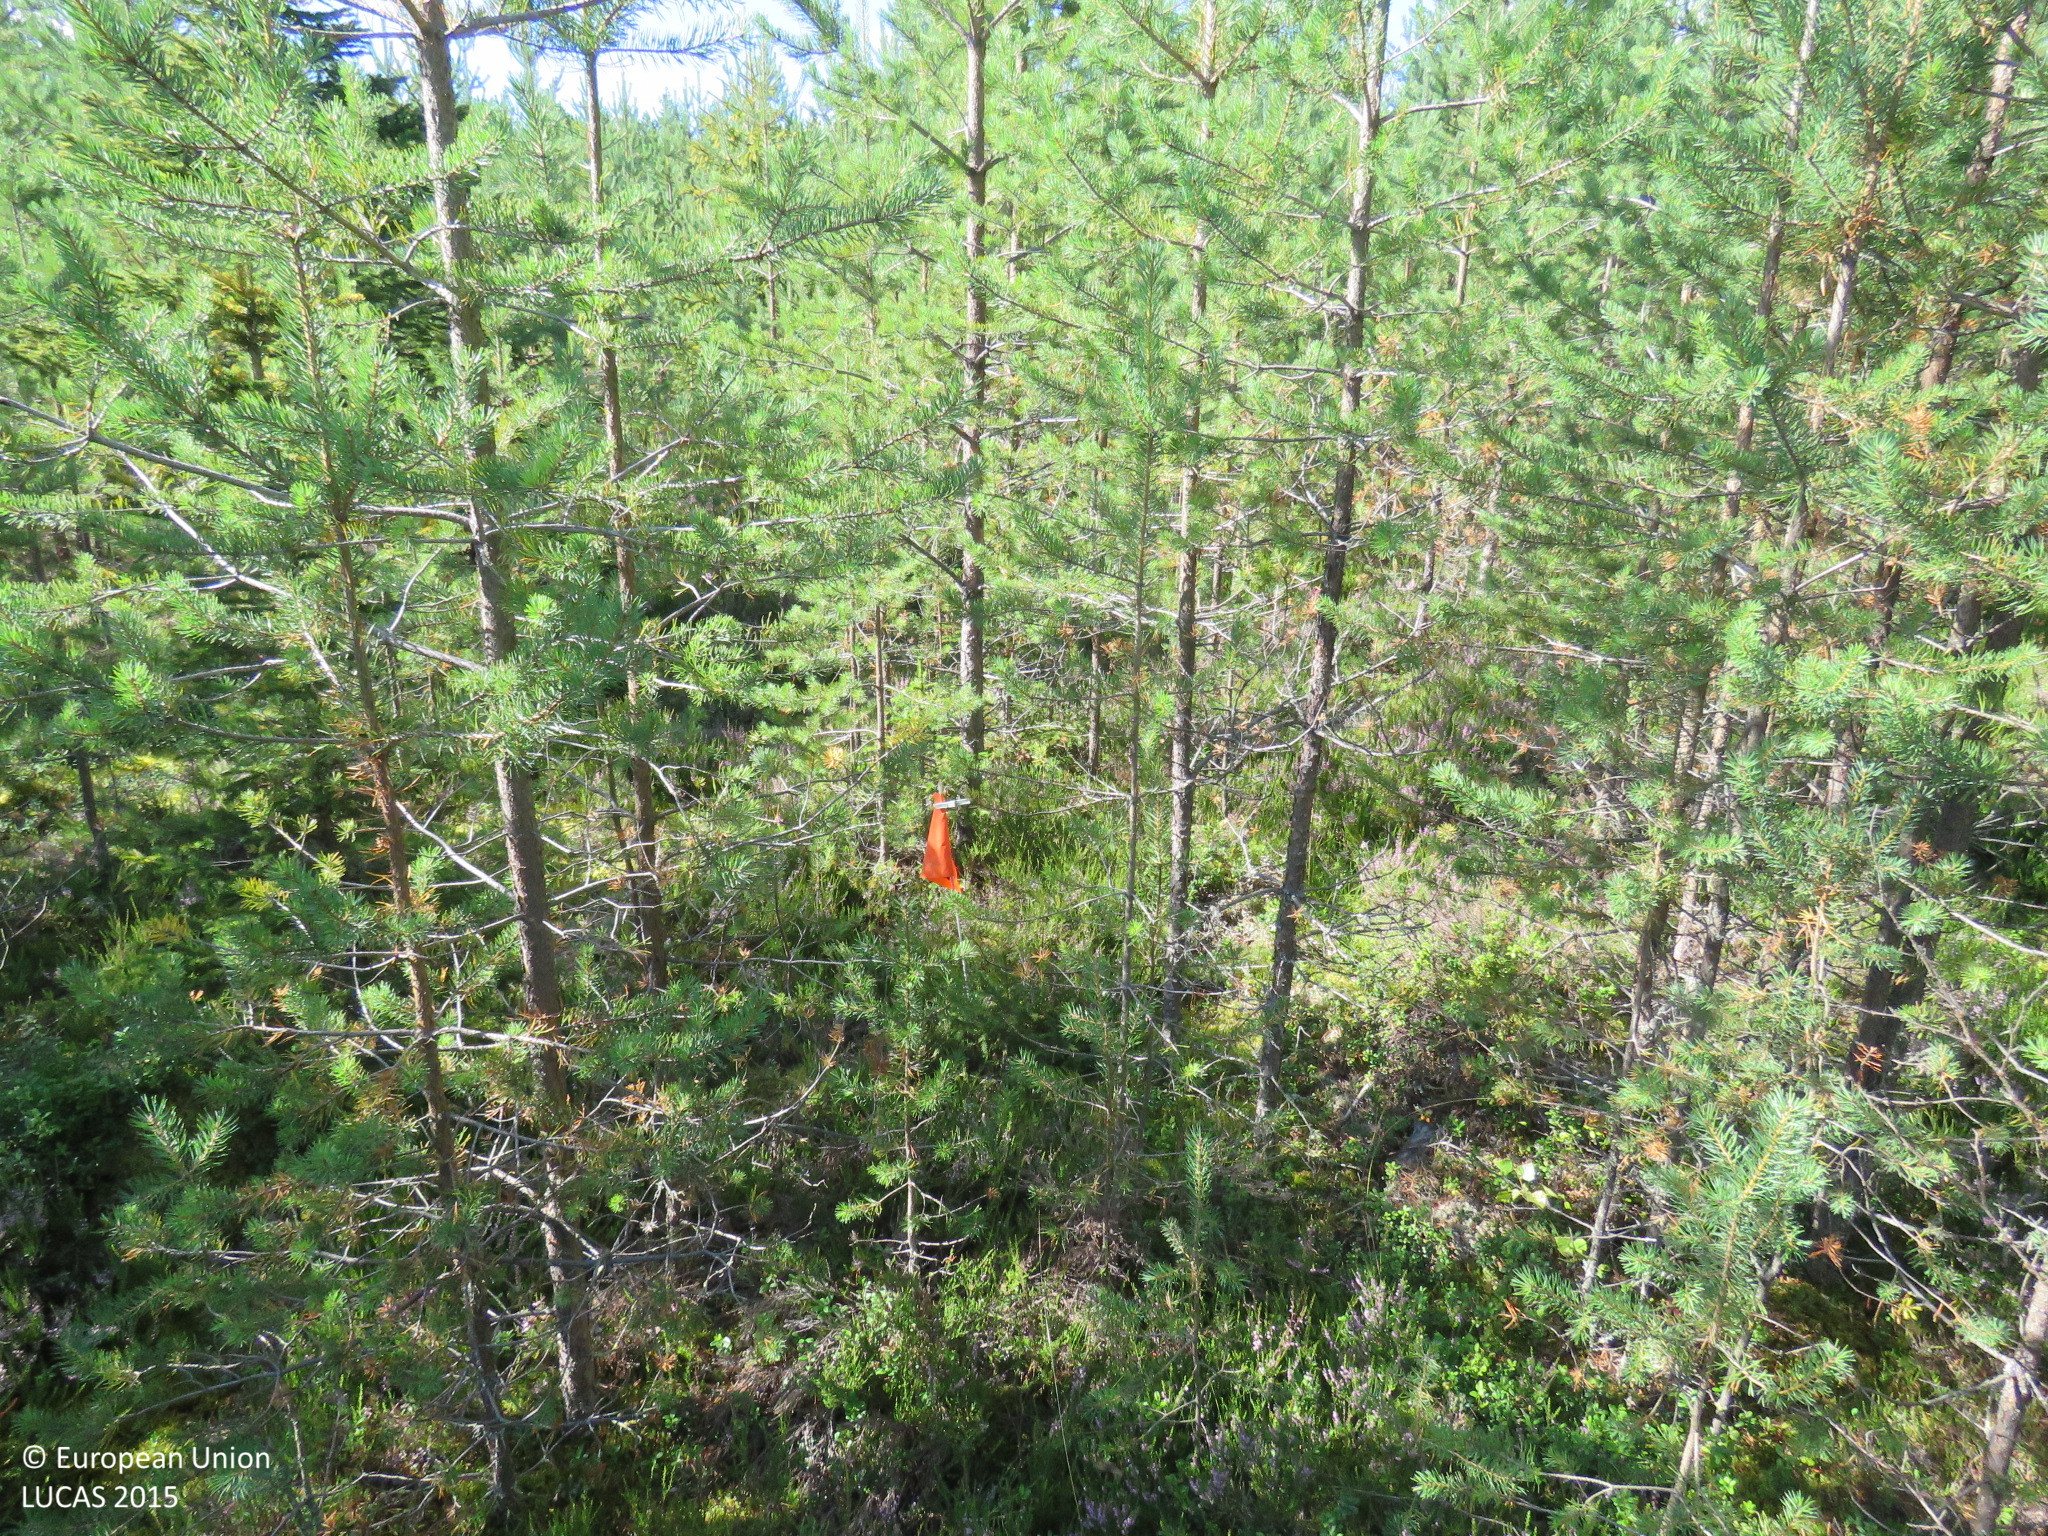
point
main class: Woodland
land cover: Pine dominated coniferous woodland
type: boreal forest
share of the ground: > 75 %
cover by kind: coniferous forest trees 85 %, shrubs 10 %, broadleaved forest trees 5 %
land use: Forestry
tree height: < 5 m
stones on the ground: < 10 %
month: August
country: FI
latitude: 65.1574
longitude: 25.7671
